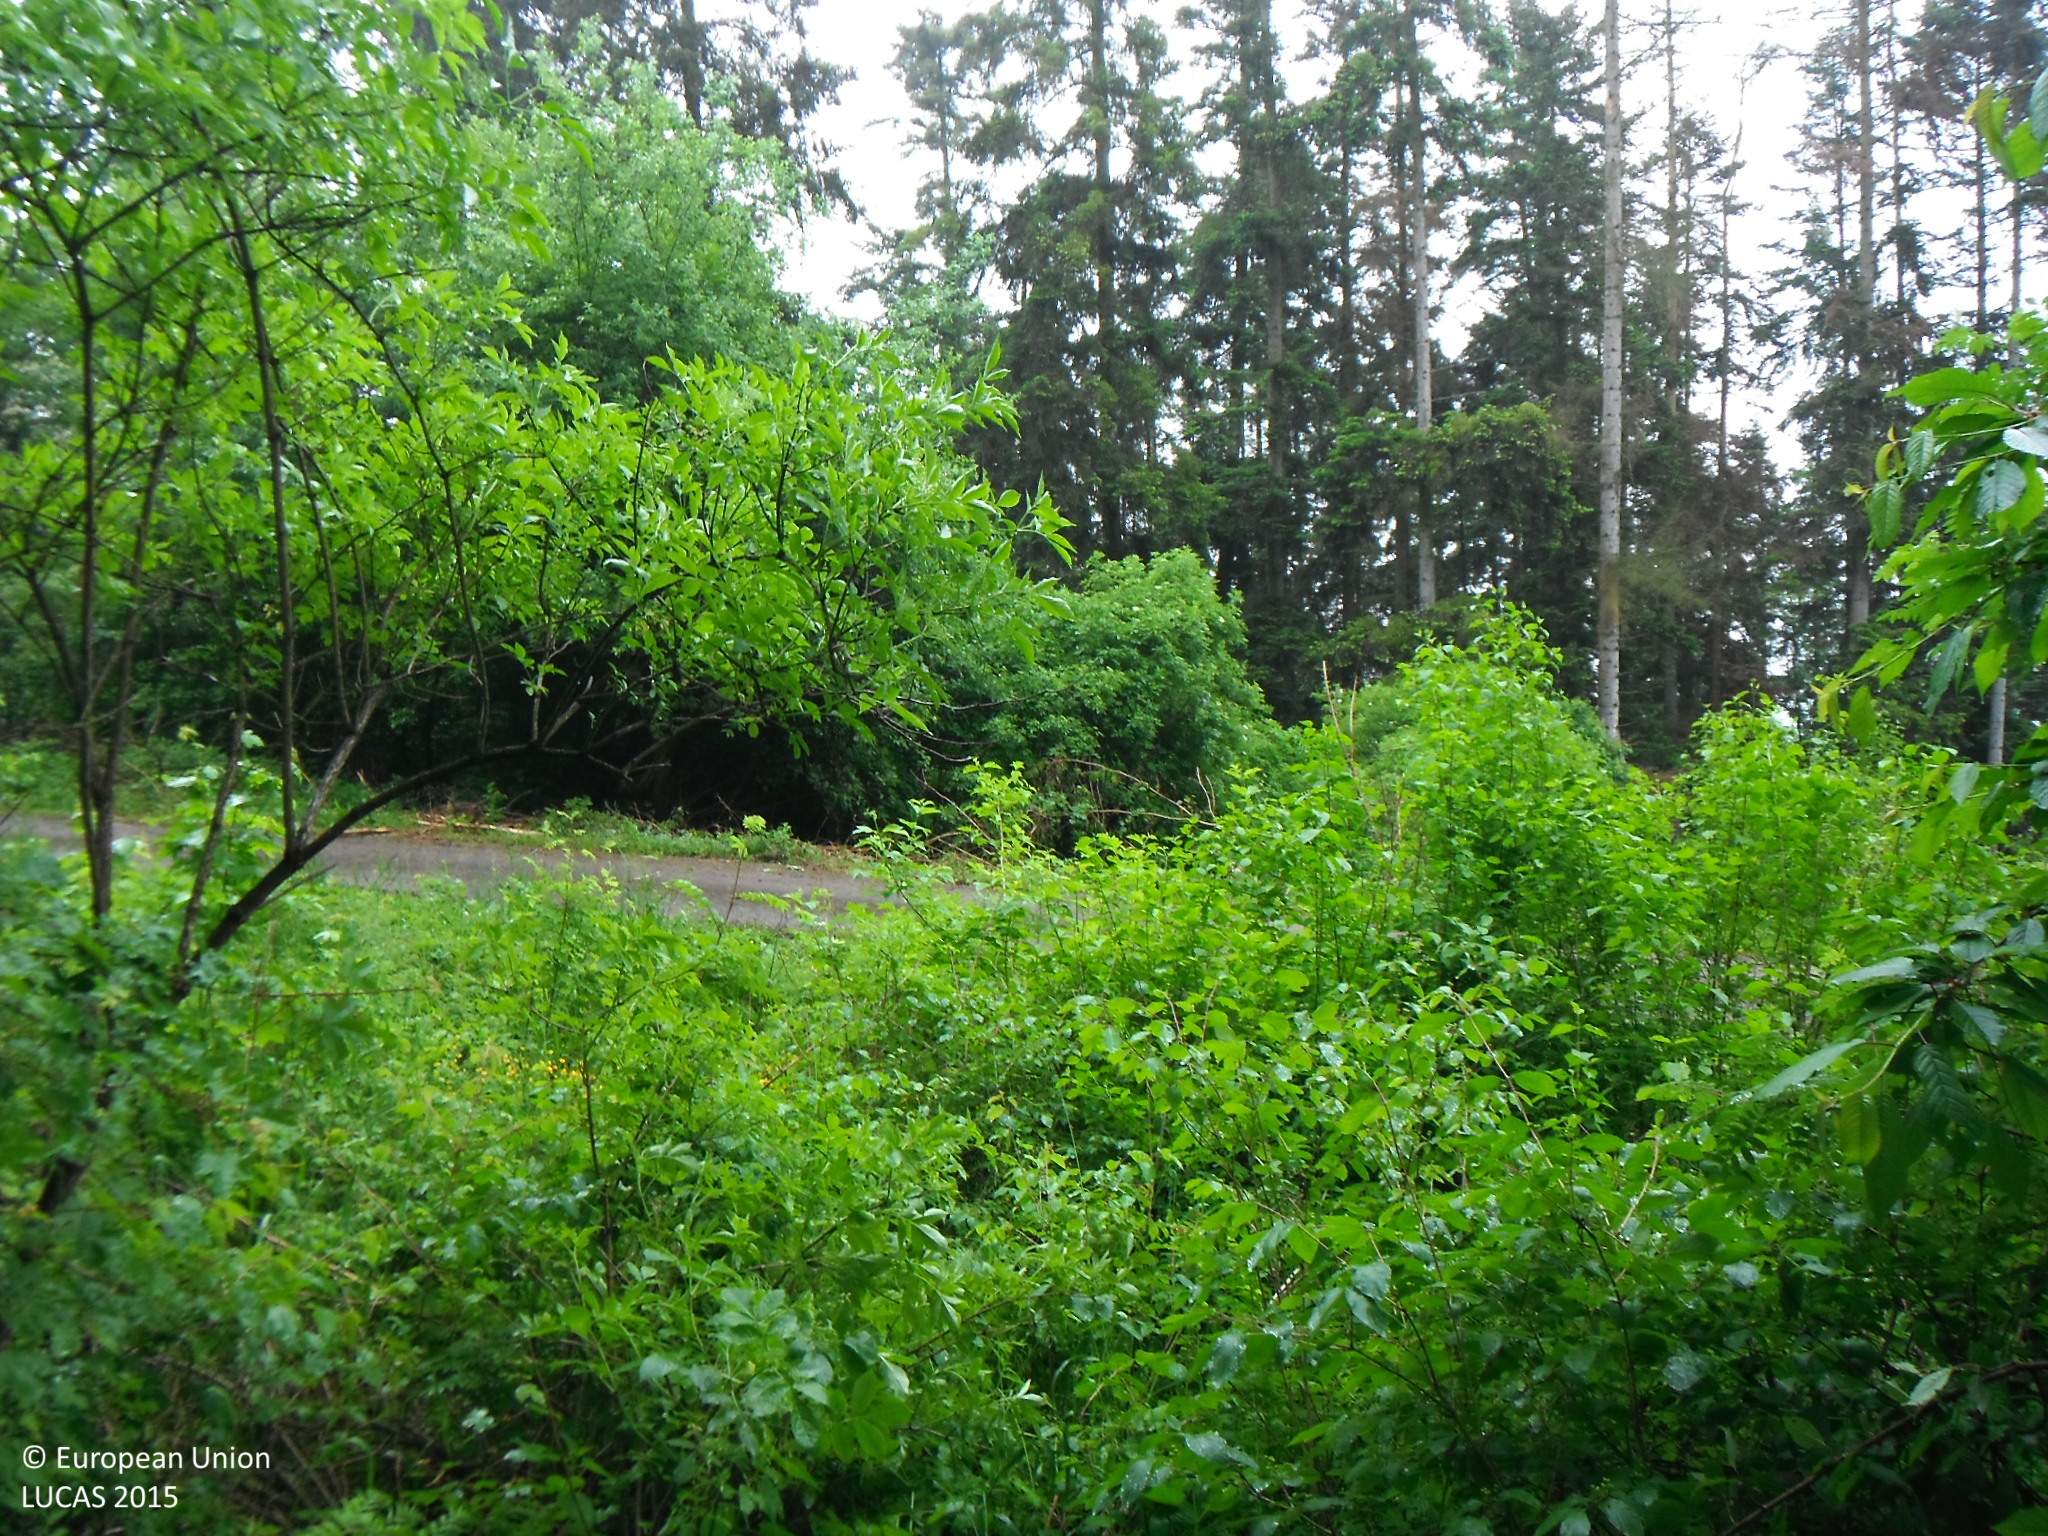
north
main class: Woodland
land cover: Other coniferous woodland
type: hemiboreal forest and nemoral coniferous forest and mixed broadleaved-coniferous forest
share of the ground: > 75 %
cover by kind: coniferous forest trees 85 %, shrubs 15 %
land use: Forestry
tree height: > 5 m
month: May
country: SK
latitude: 48.9993
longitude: 21.1565
